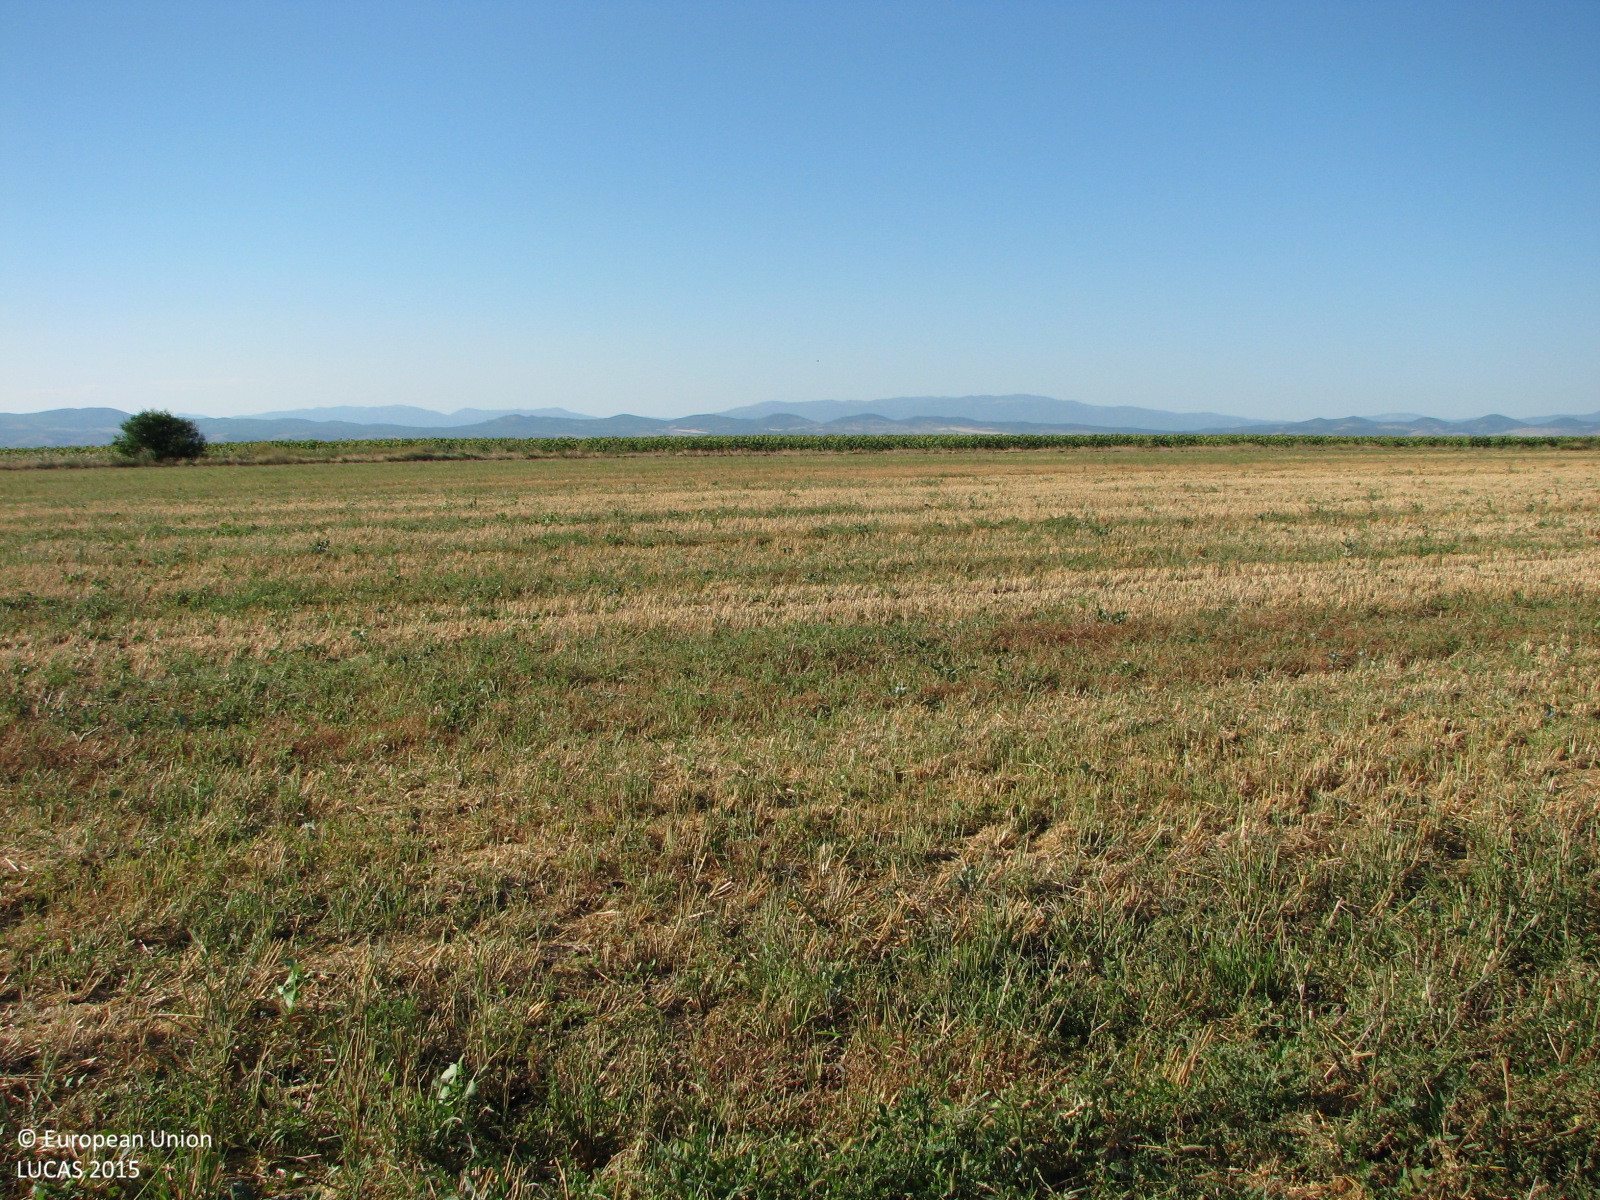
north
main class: Cropland
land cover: Common wheat
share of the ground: 10 - 25 %
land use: Agriculture (excluding fallow land and kitchen gardens)
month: July
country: BG
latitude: 42.4040
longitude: 25.9836
